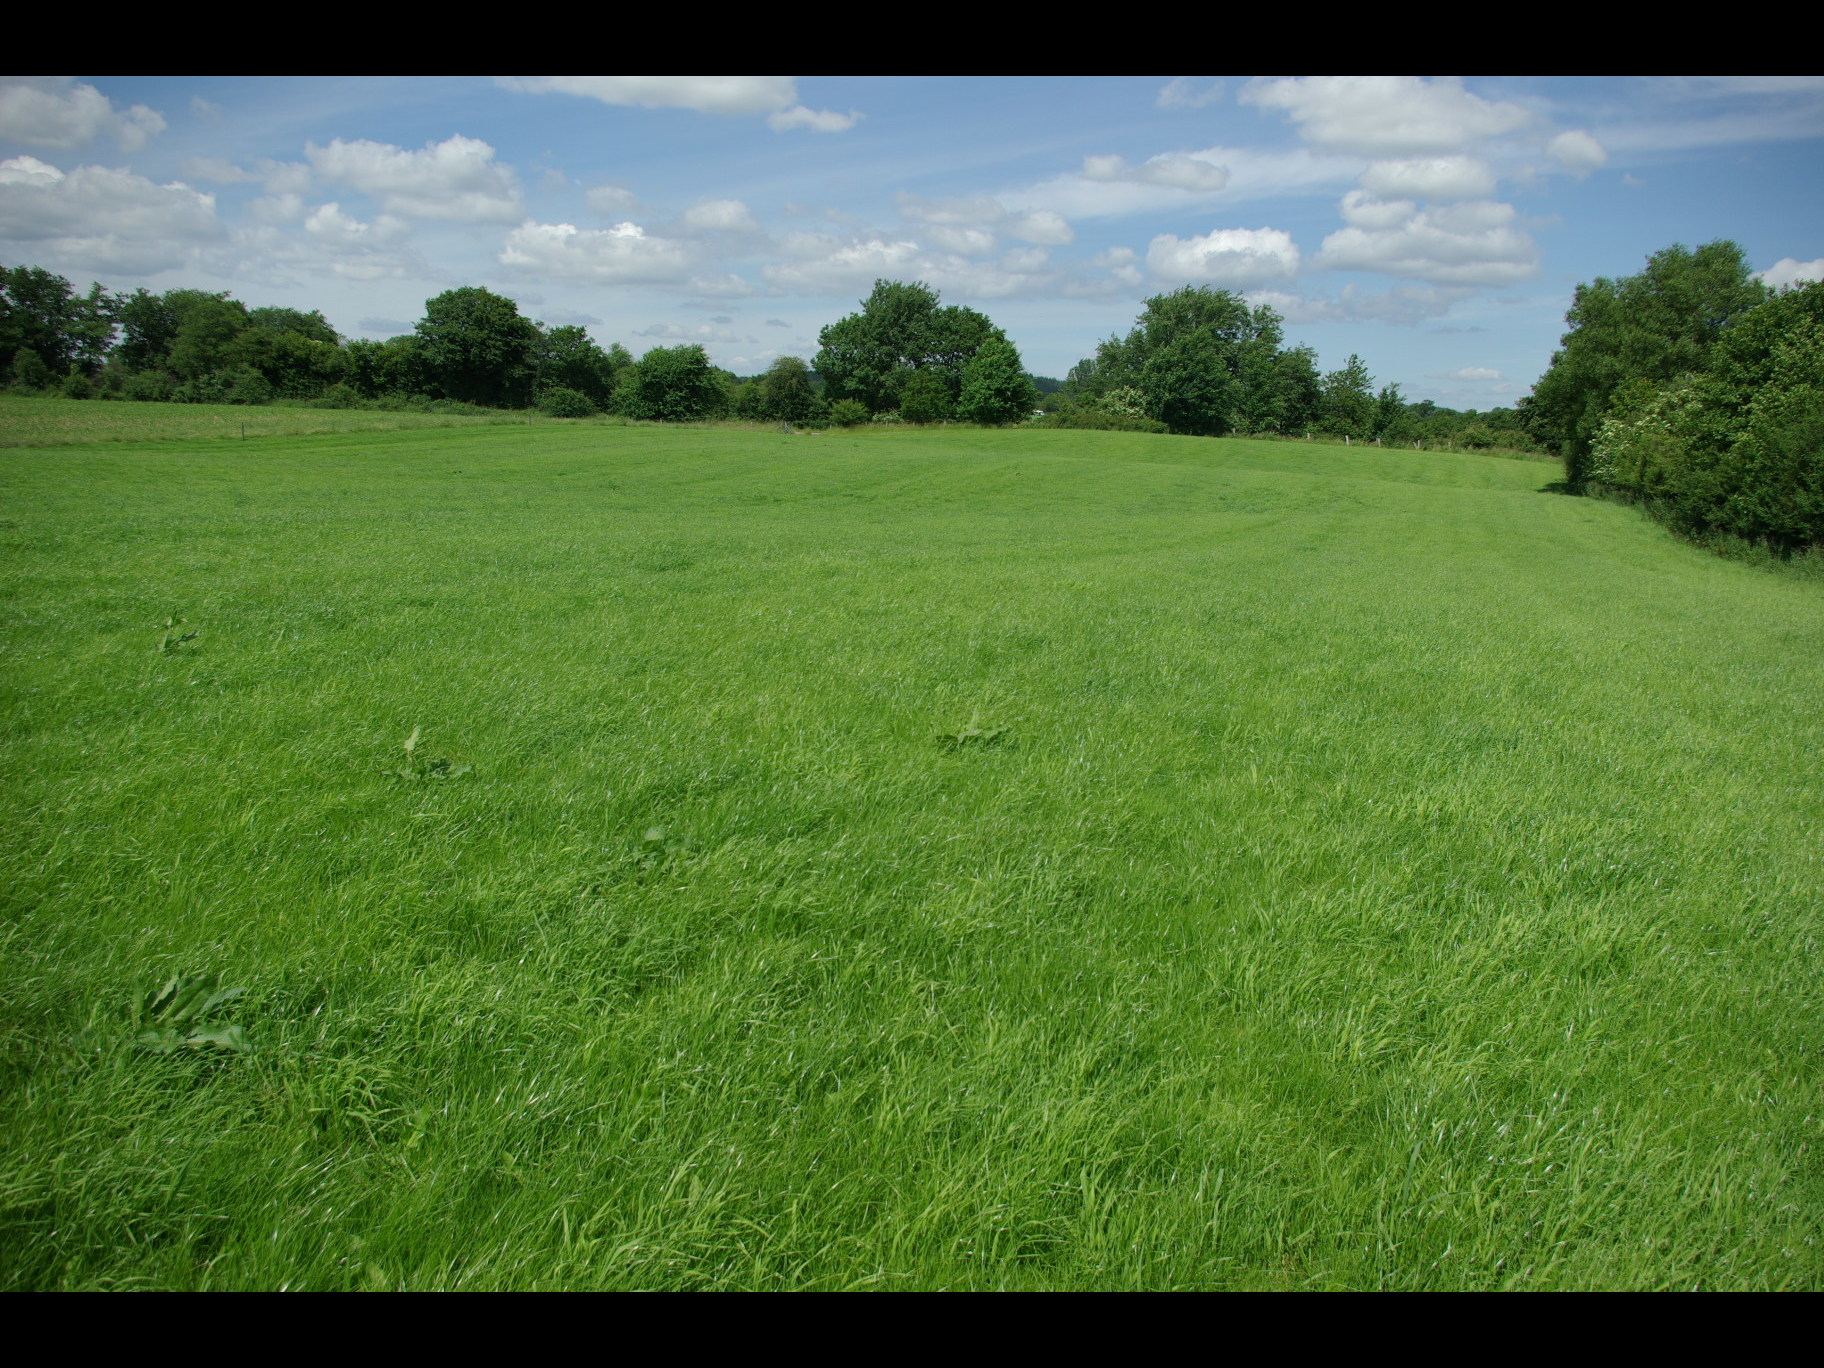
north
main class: Grassland
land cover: Grassland without tree/shrub cover
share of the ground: > 75 %
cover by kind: herbaceous plants 100 %
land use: Agriculture (excluding fallow land and kitchen gardens)
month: June
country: DE
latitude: 54.3899
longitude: 9.6460
